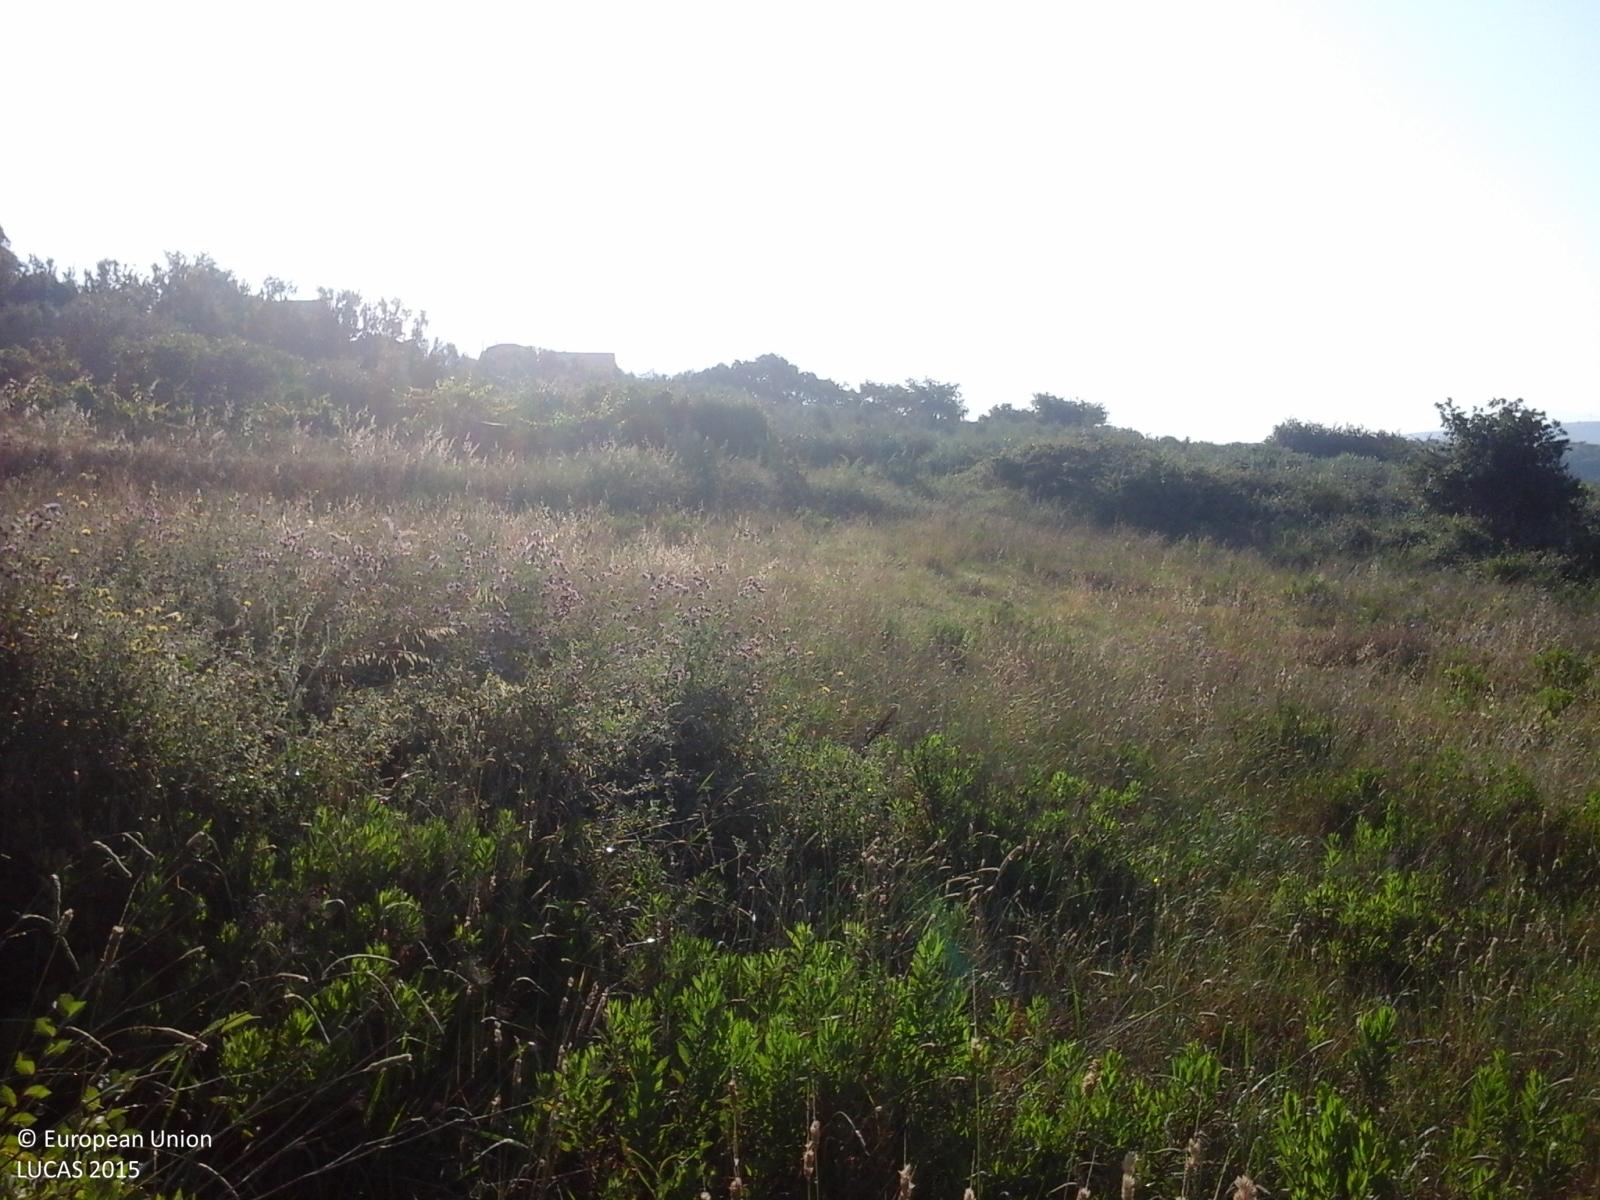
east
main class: Grassland
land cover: Grassland without tree/shrub cover
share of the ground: > 75 %
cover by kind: herbaceous plants 100 %
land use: Abandoned areas
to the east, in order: Grassland without tree/shrub cover; Electric lines; Shrubland without tree cover; Ditches and canals; Spontaneously vegetated surfaces; Olive groves; Shrubland with sparse tree cover; Tracks; Spontaneously vegetated surfaces; Broadleaved woodland; Other bare soil; Artificial constructions in urban areas
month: June
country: IT
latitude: 40.6507
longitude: 14.9347
